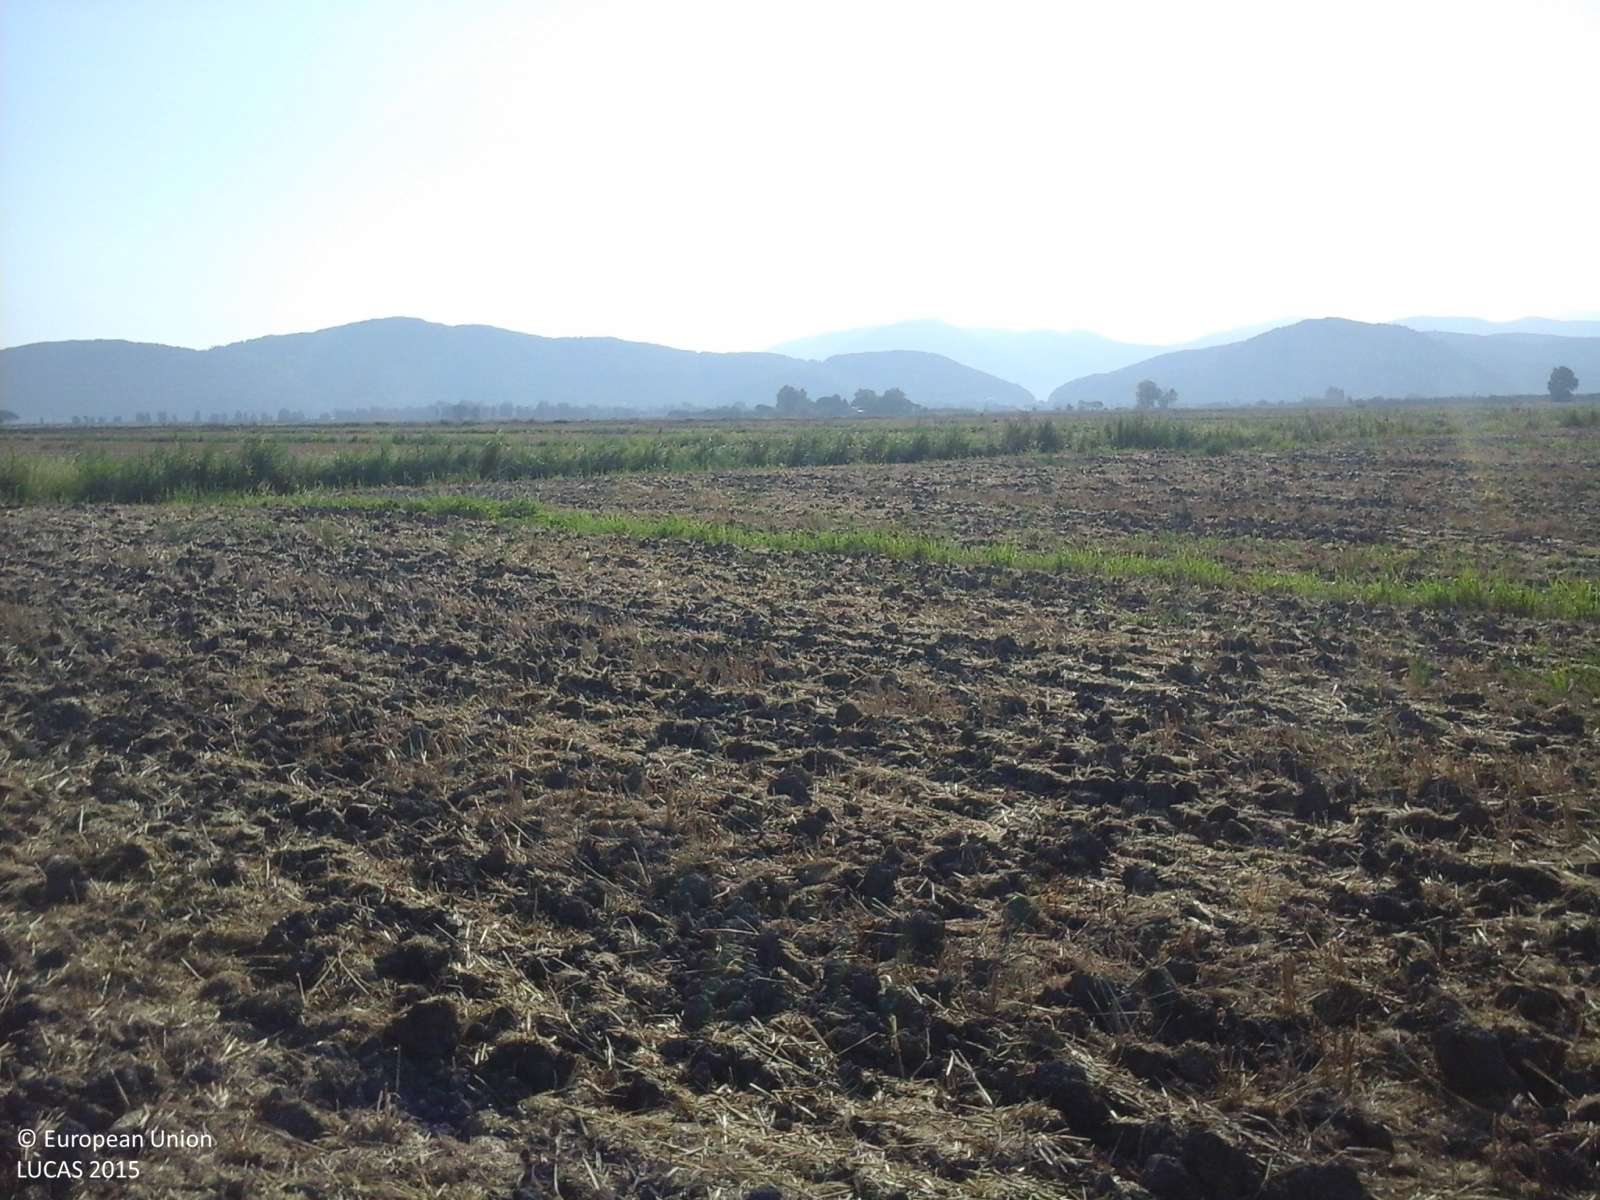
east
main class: Cropland
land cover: Common wheat
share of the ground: > 75 %
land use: Agriculture (excluding fallow land and kitchen gardens)
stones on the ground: < 10 %
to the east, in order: Common wheat; Ditches and canals; Common wheat; Ditches and canals; Common wheat; Ditches and canals; Common wheat; Ditches and canals; Common wheat; Ditches and canals; Common wheat
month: August
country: IT
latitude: 43.8088
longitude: 10.3347
